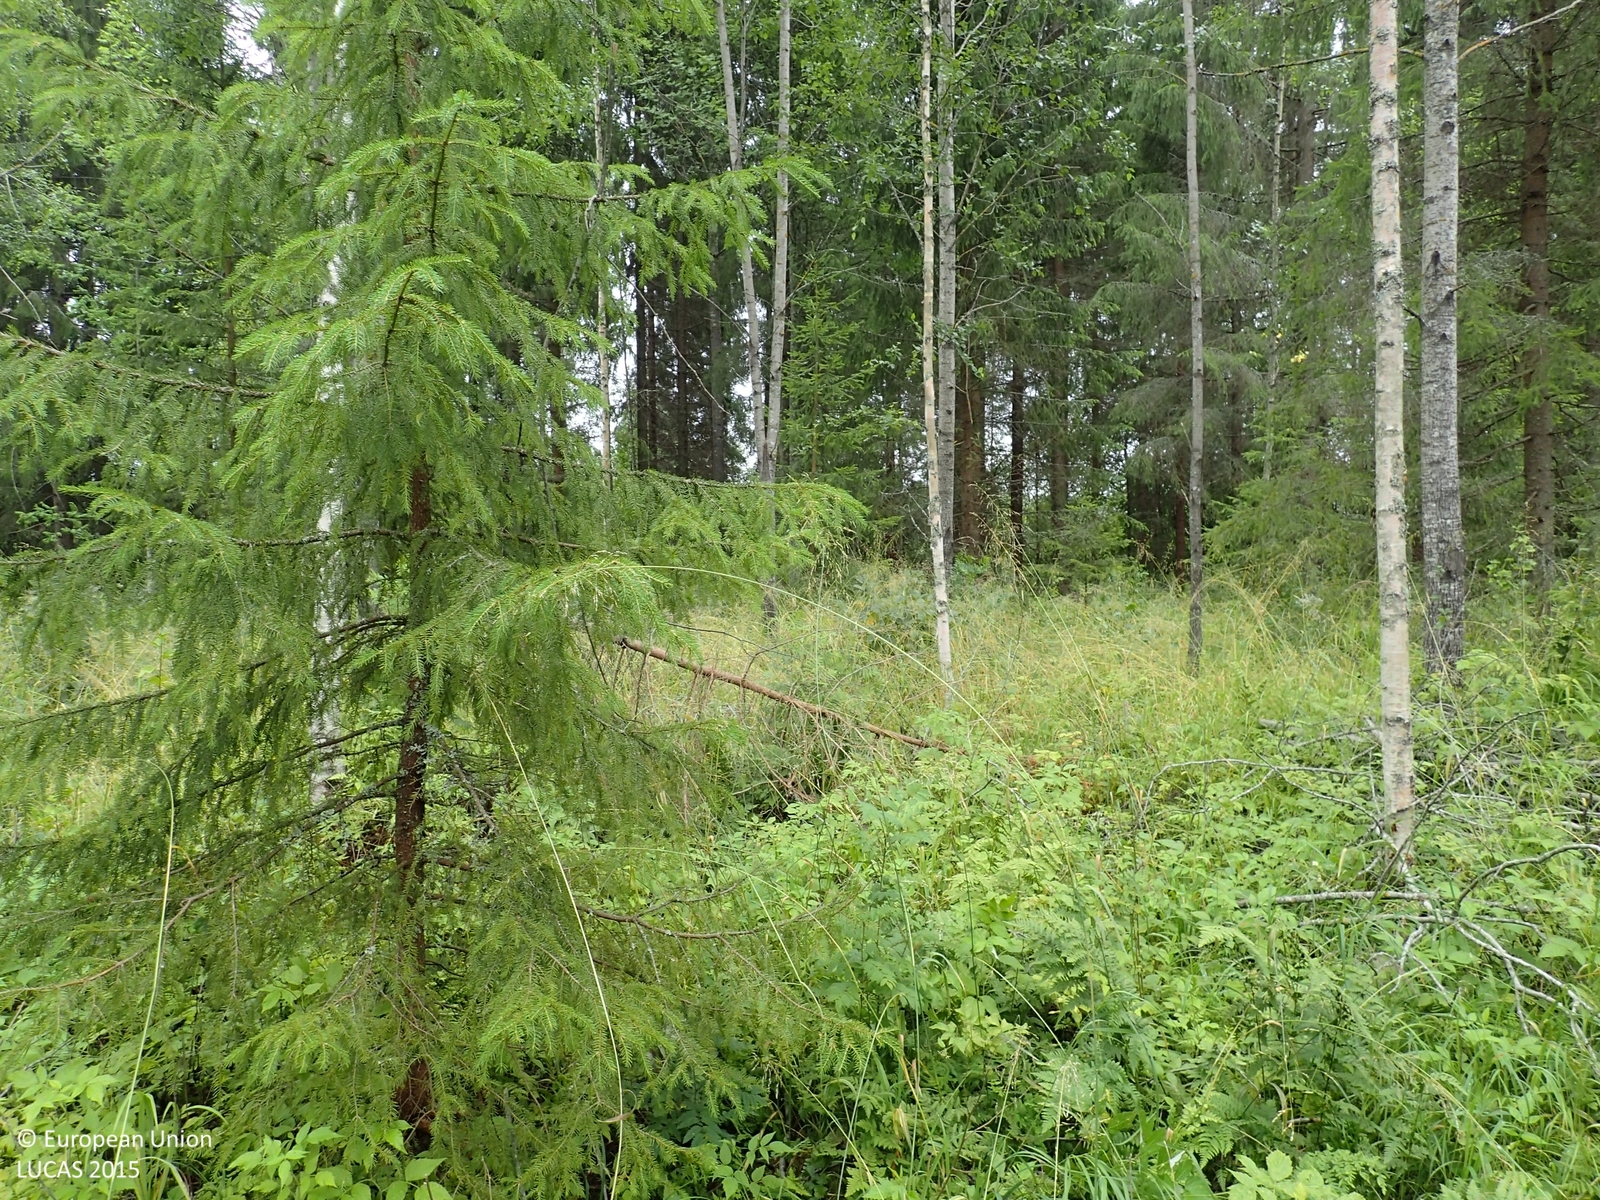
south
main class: Woodland
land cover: Spruce dominated mixed woodland
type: boreal forest
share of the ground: 50 - 75 %
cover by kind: coniferous forest trees 45 %, herbaceous plants 40 %, broadleaved forest trees 15 %
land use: Forestry
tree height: > 5 m
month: July
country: FI
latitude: 62.9550
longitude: 22.6509
